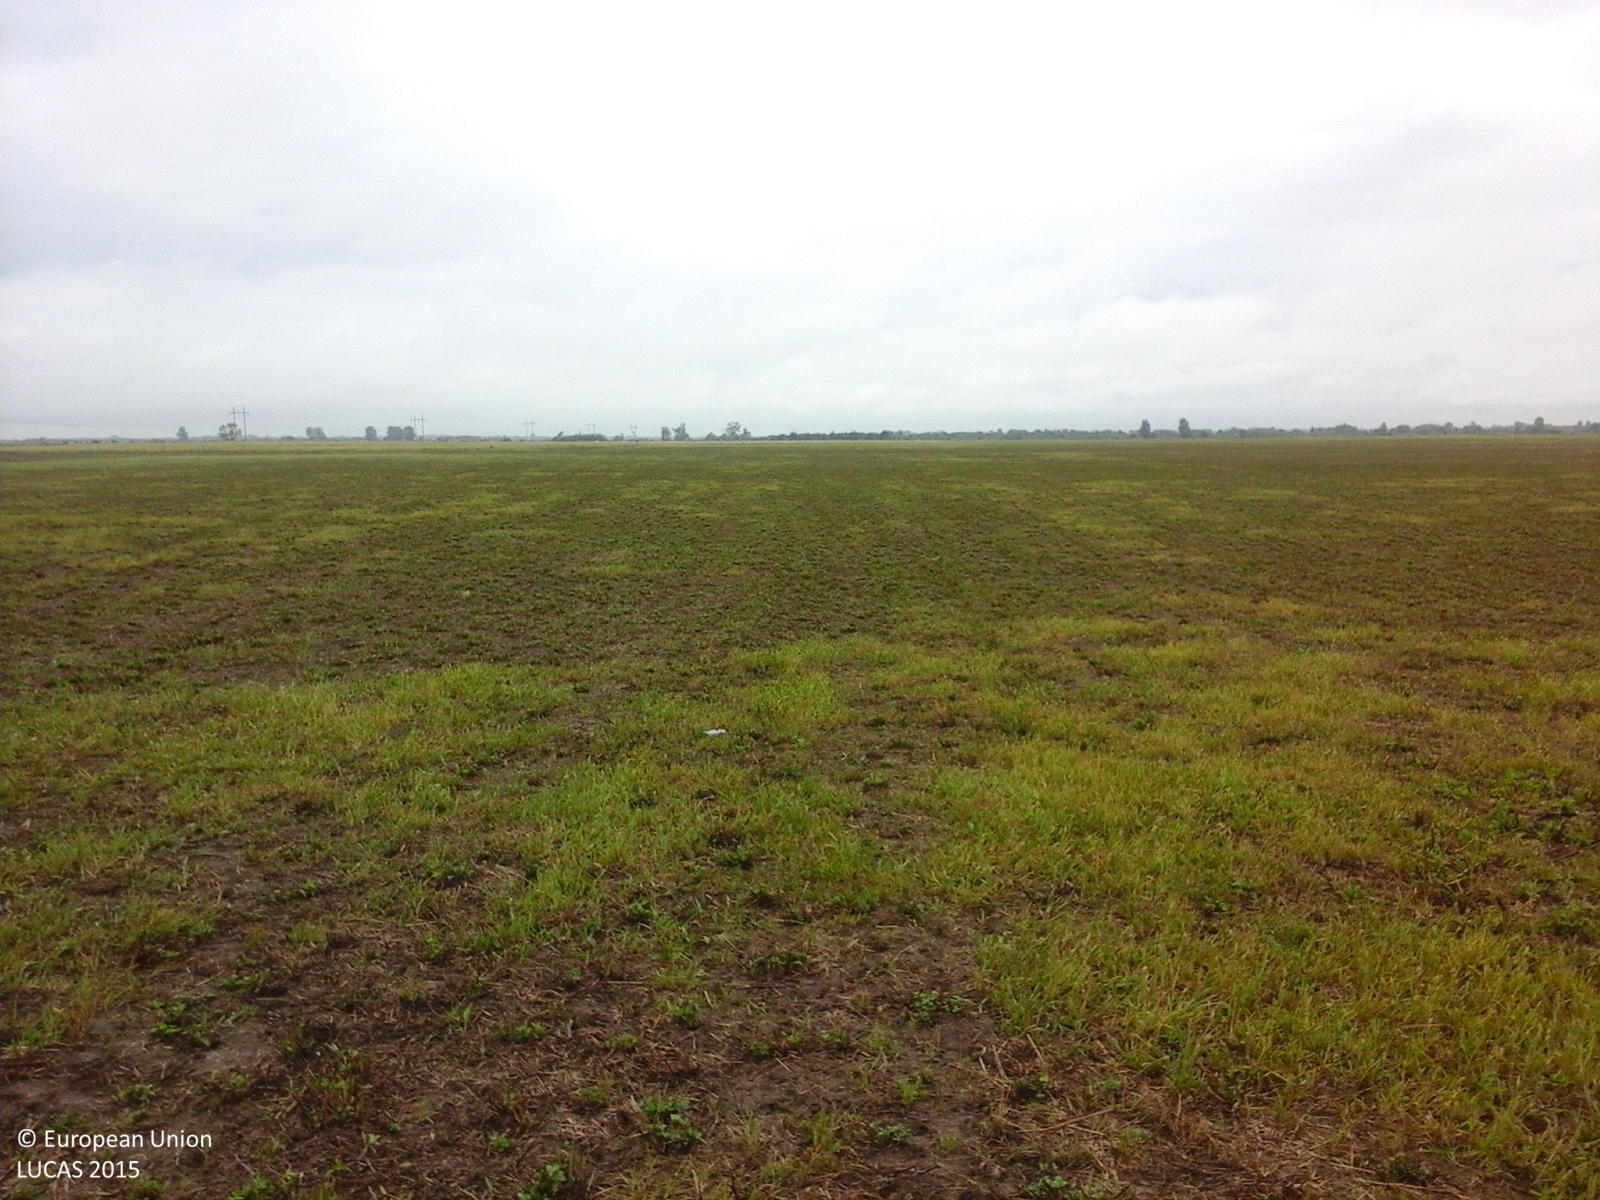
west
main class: Grassland
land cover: Grassland without tree/shrub cover
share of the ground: > 75 %
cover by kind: herbaceous plants 100 %
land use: Agriculture (excluding fallow land and kitchen gardens)
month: August
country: RO
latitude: 45.6362
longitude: 21.5148
